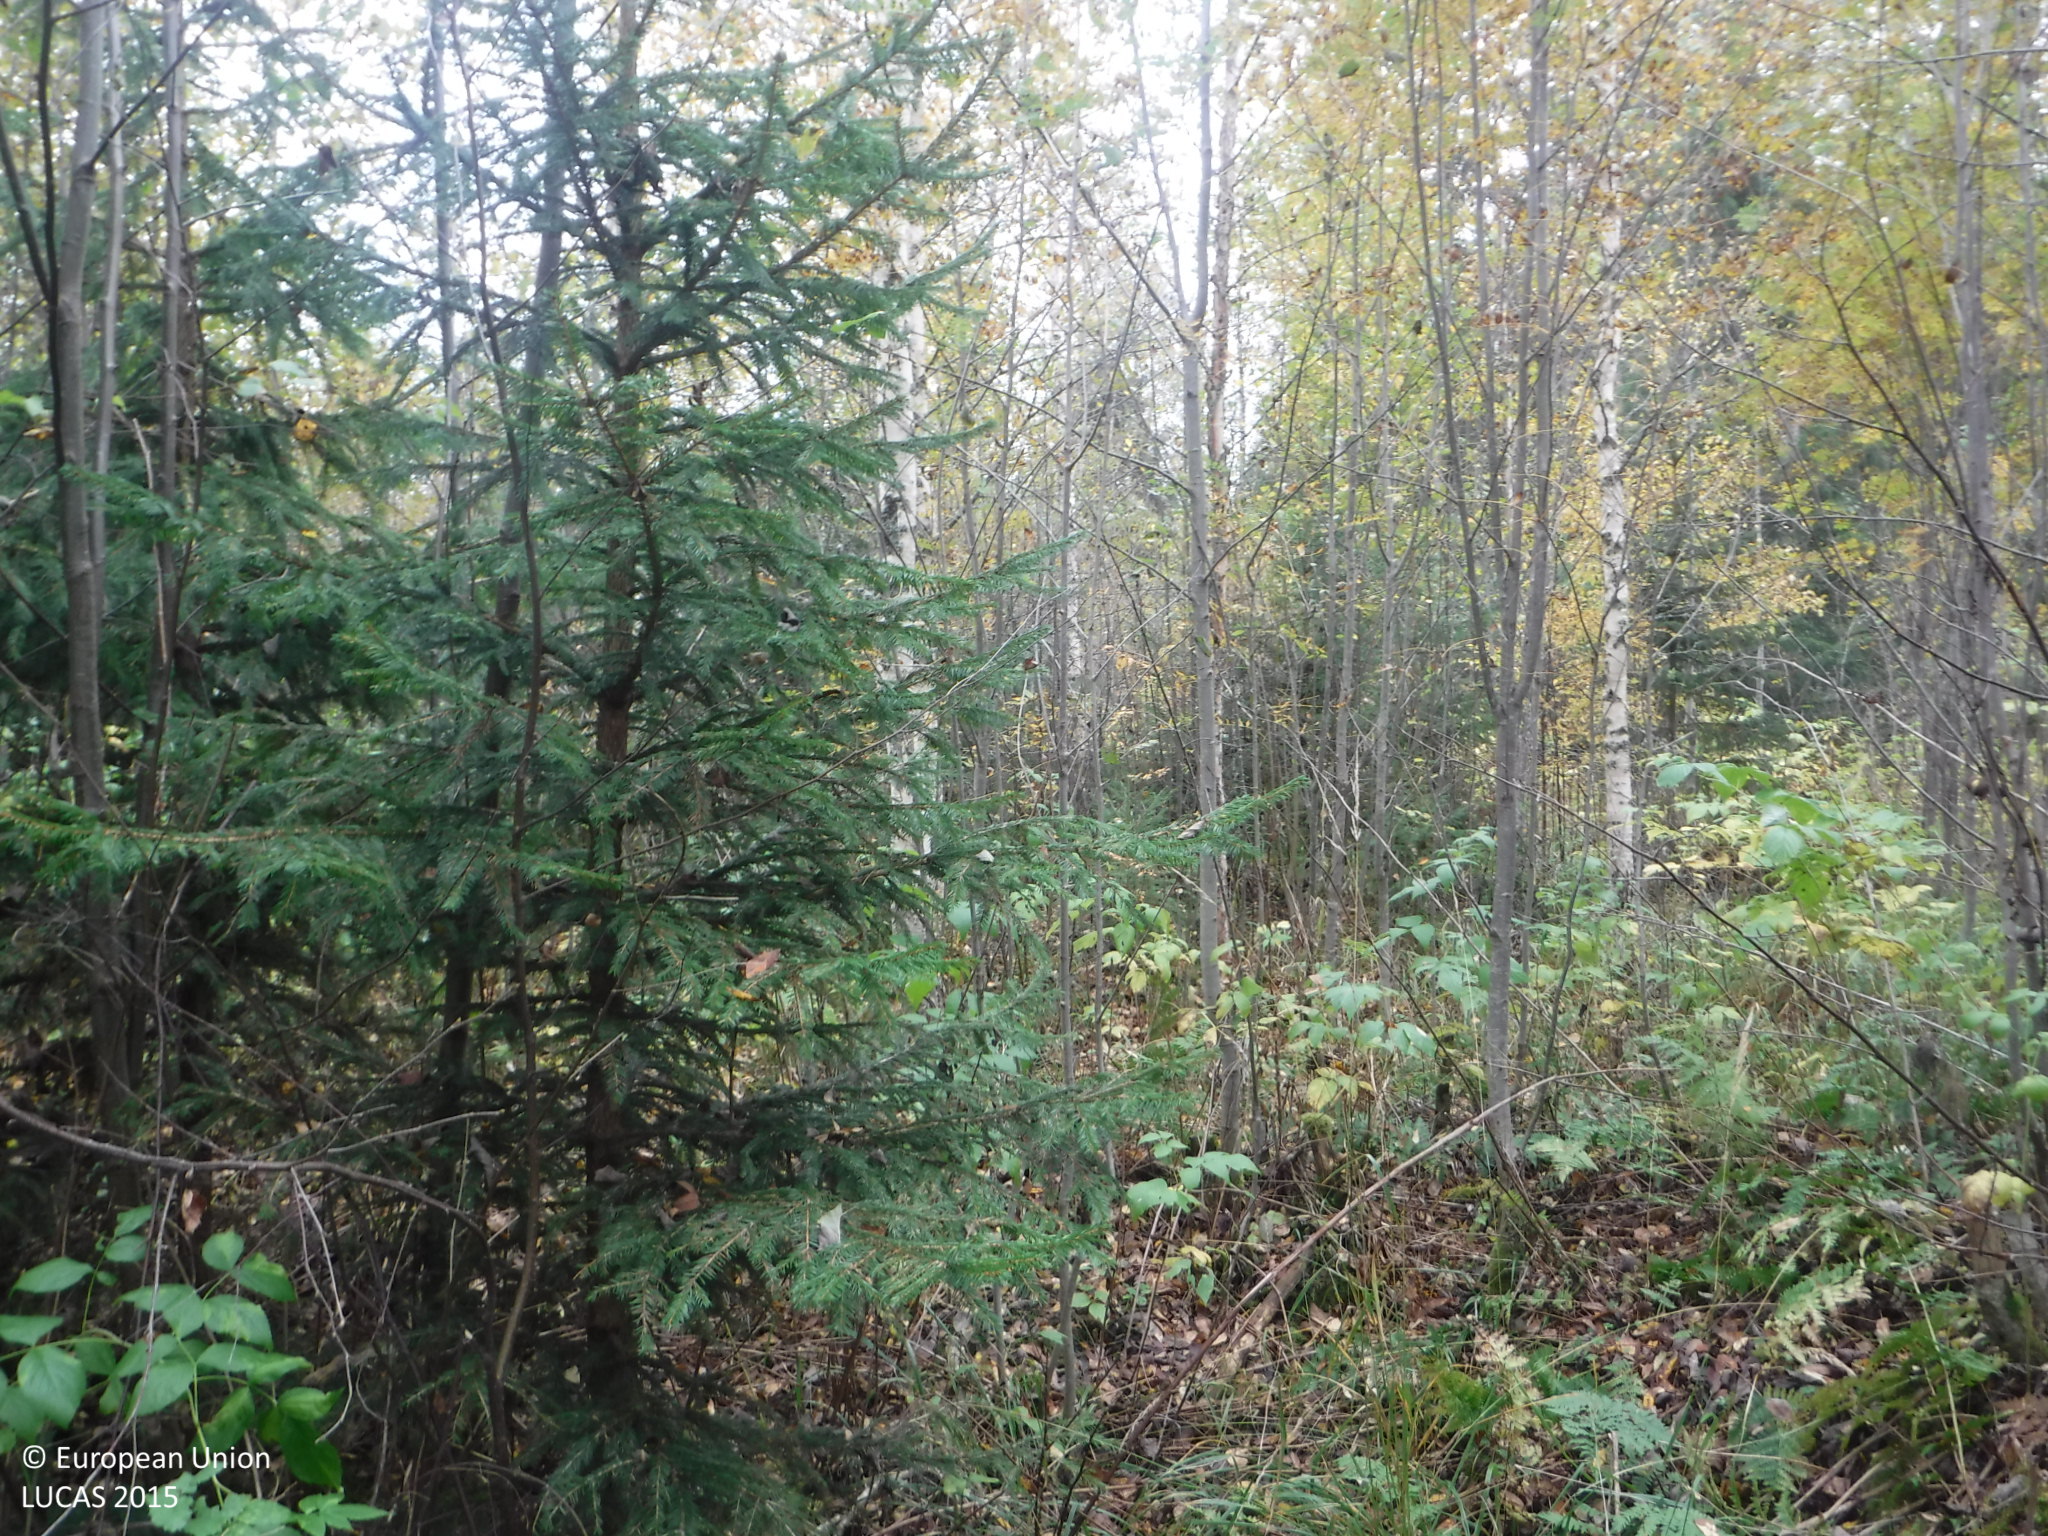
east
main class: Woodland
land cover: Broadleaved woodland
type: boreal forest
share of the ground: > 75 %
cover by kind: broadleaved forest trees 75 %, coniferous forest trees 10 %, lichens and mosses 10 %, shrubs 5 %
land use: Forestry
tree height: > 5 m
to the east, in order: Broadleaved woodland; Ditches and canals; Grass margins; Paved roads, cycling and walking lanes; Grass margins; Ditches and canals; Other mixed woodland; Ditches and canals; Other mixed woodland; Tracks; Other mixed woodland; Ditches and canals; Spruce dominated mixed woodland; Broadleaved woodland; Pine dominated mixed woodland
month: September
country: FI
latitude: 61.7405
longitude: 24.1182
